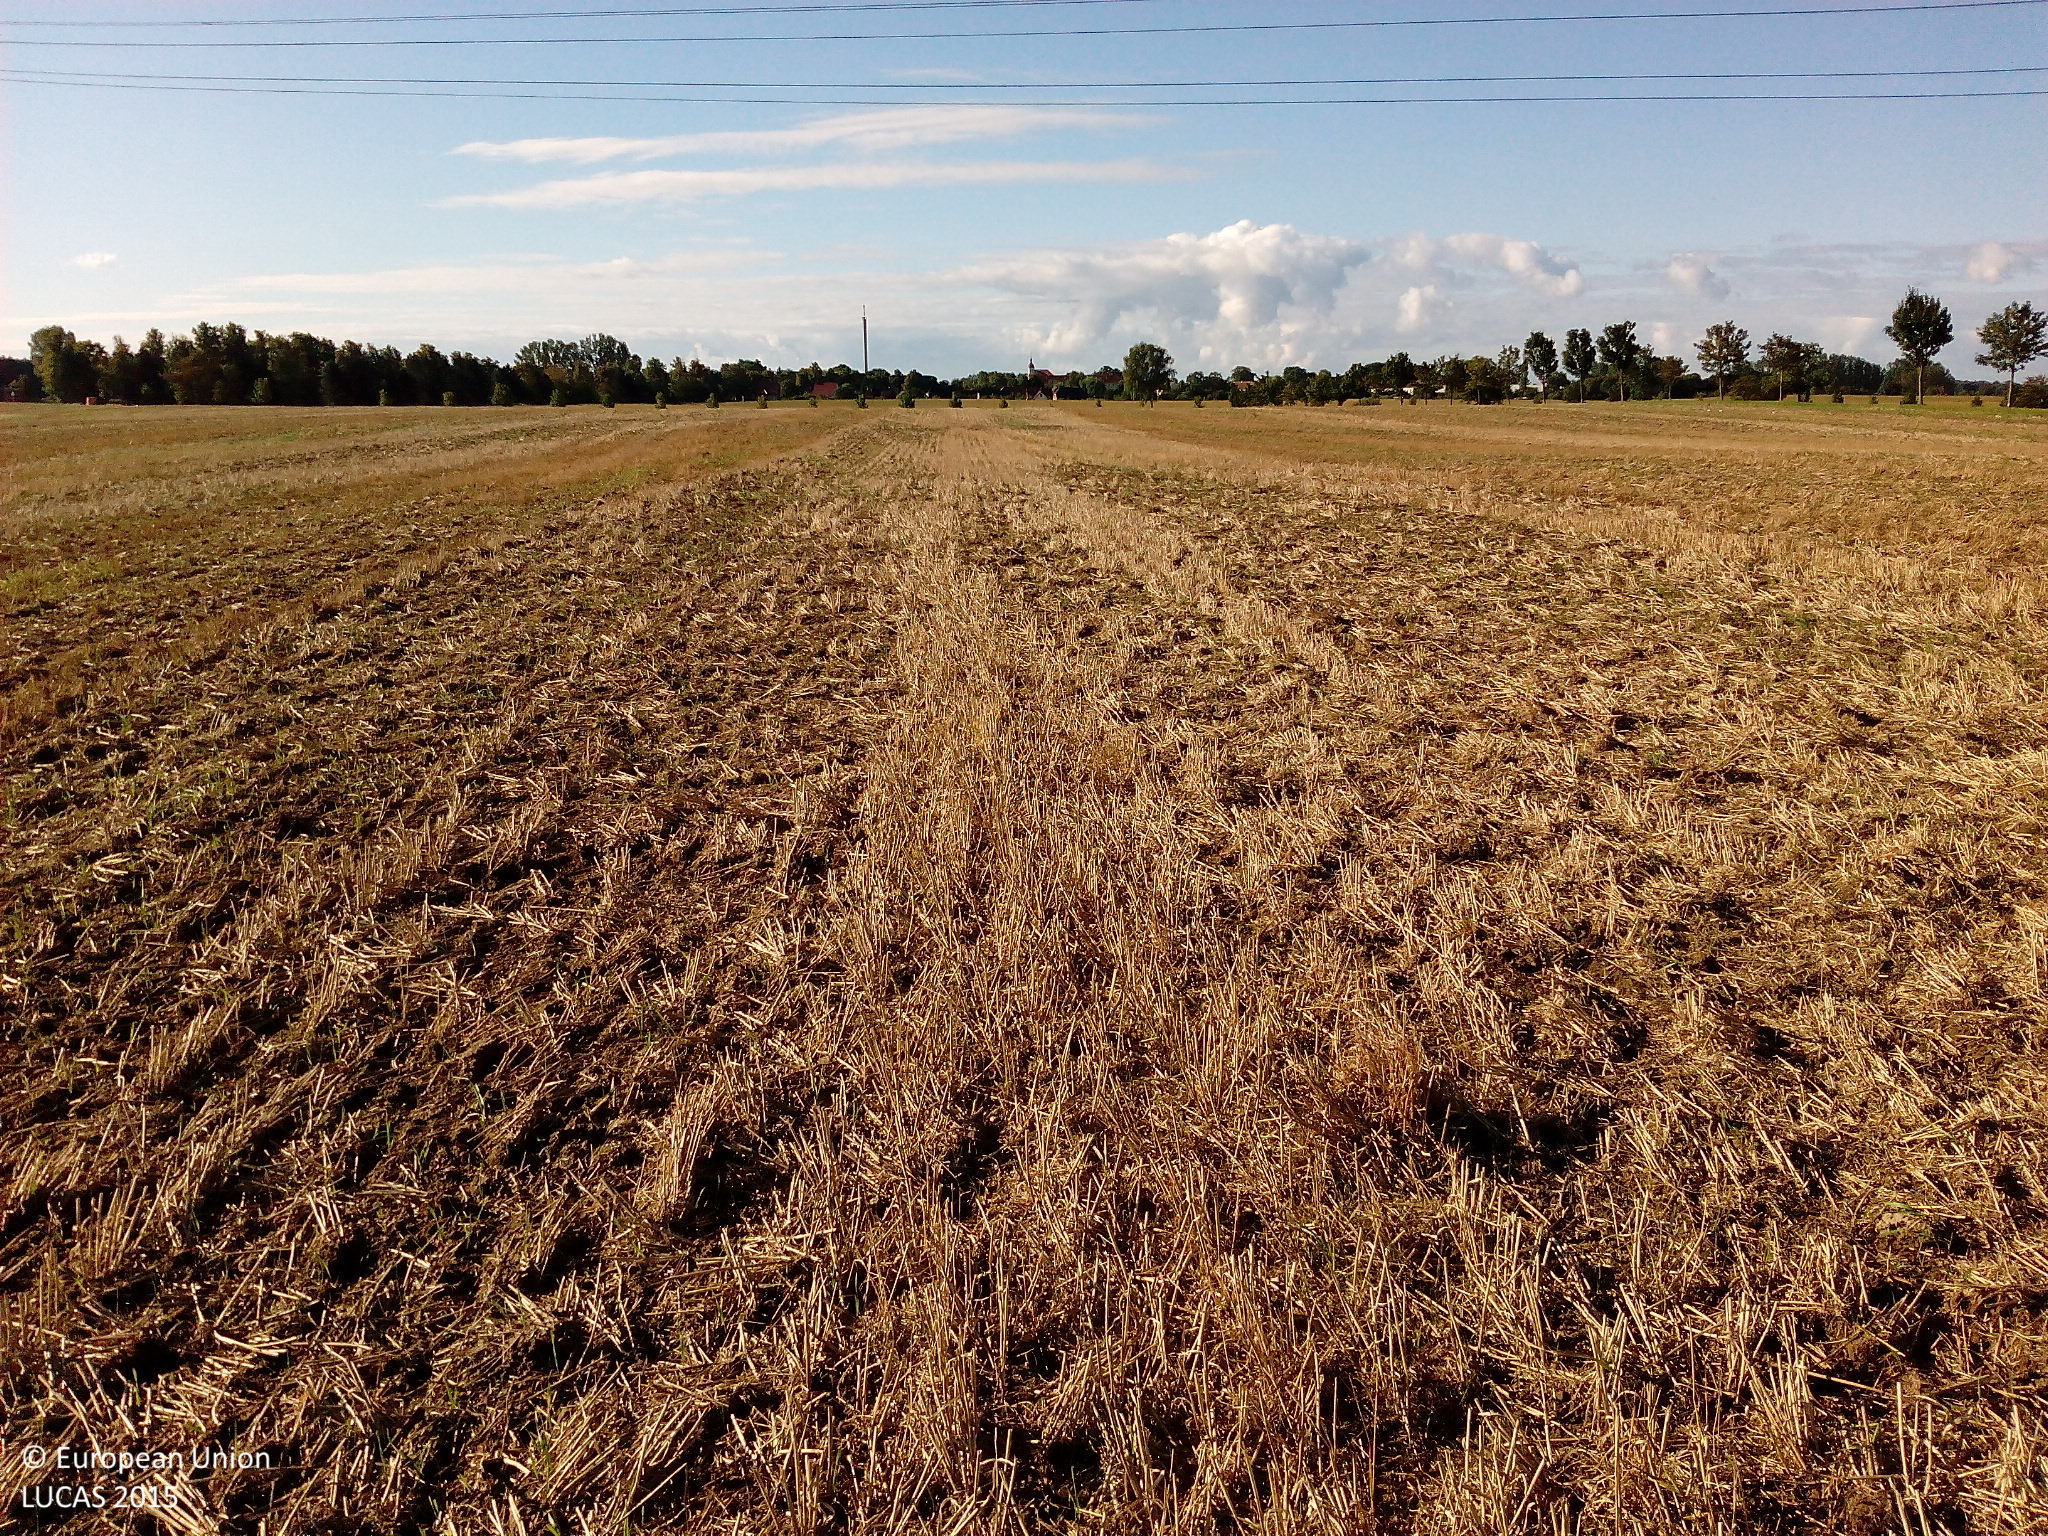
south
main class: Cropland
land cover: Common wheat
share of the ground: 10 - 25 %
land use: Agriculture (excluding fallow land and kitchen gardens)
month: September
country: DE
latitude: 54.0806
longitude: 12.3377
